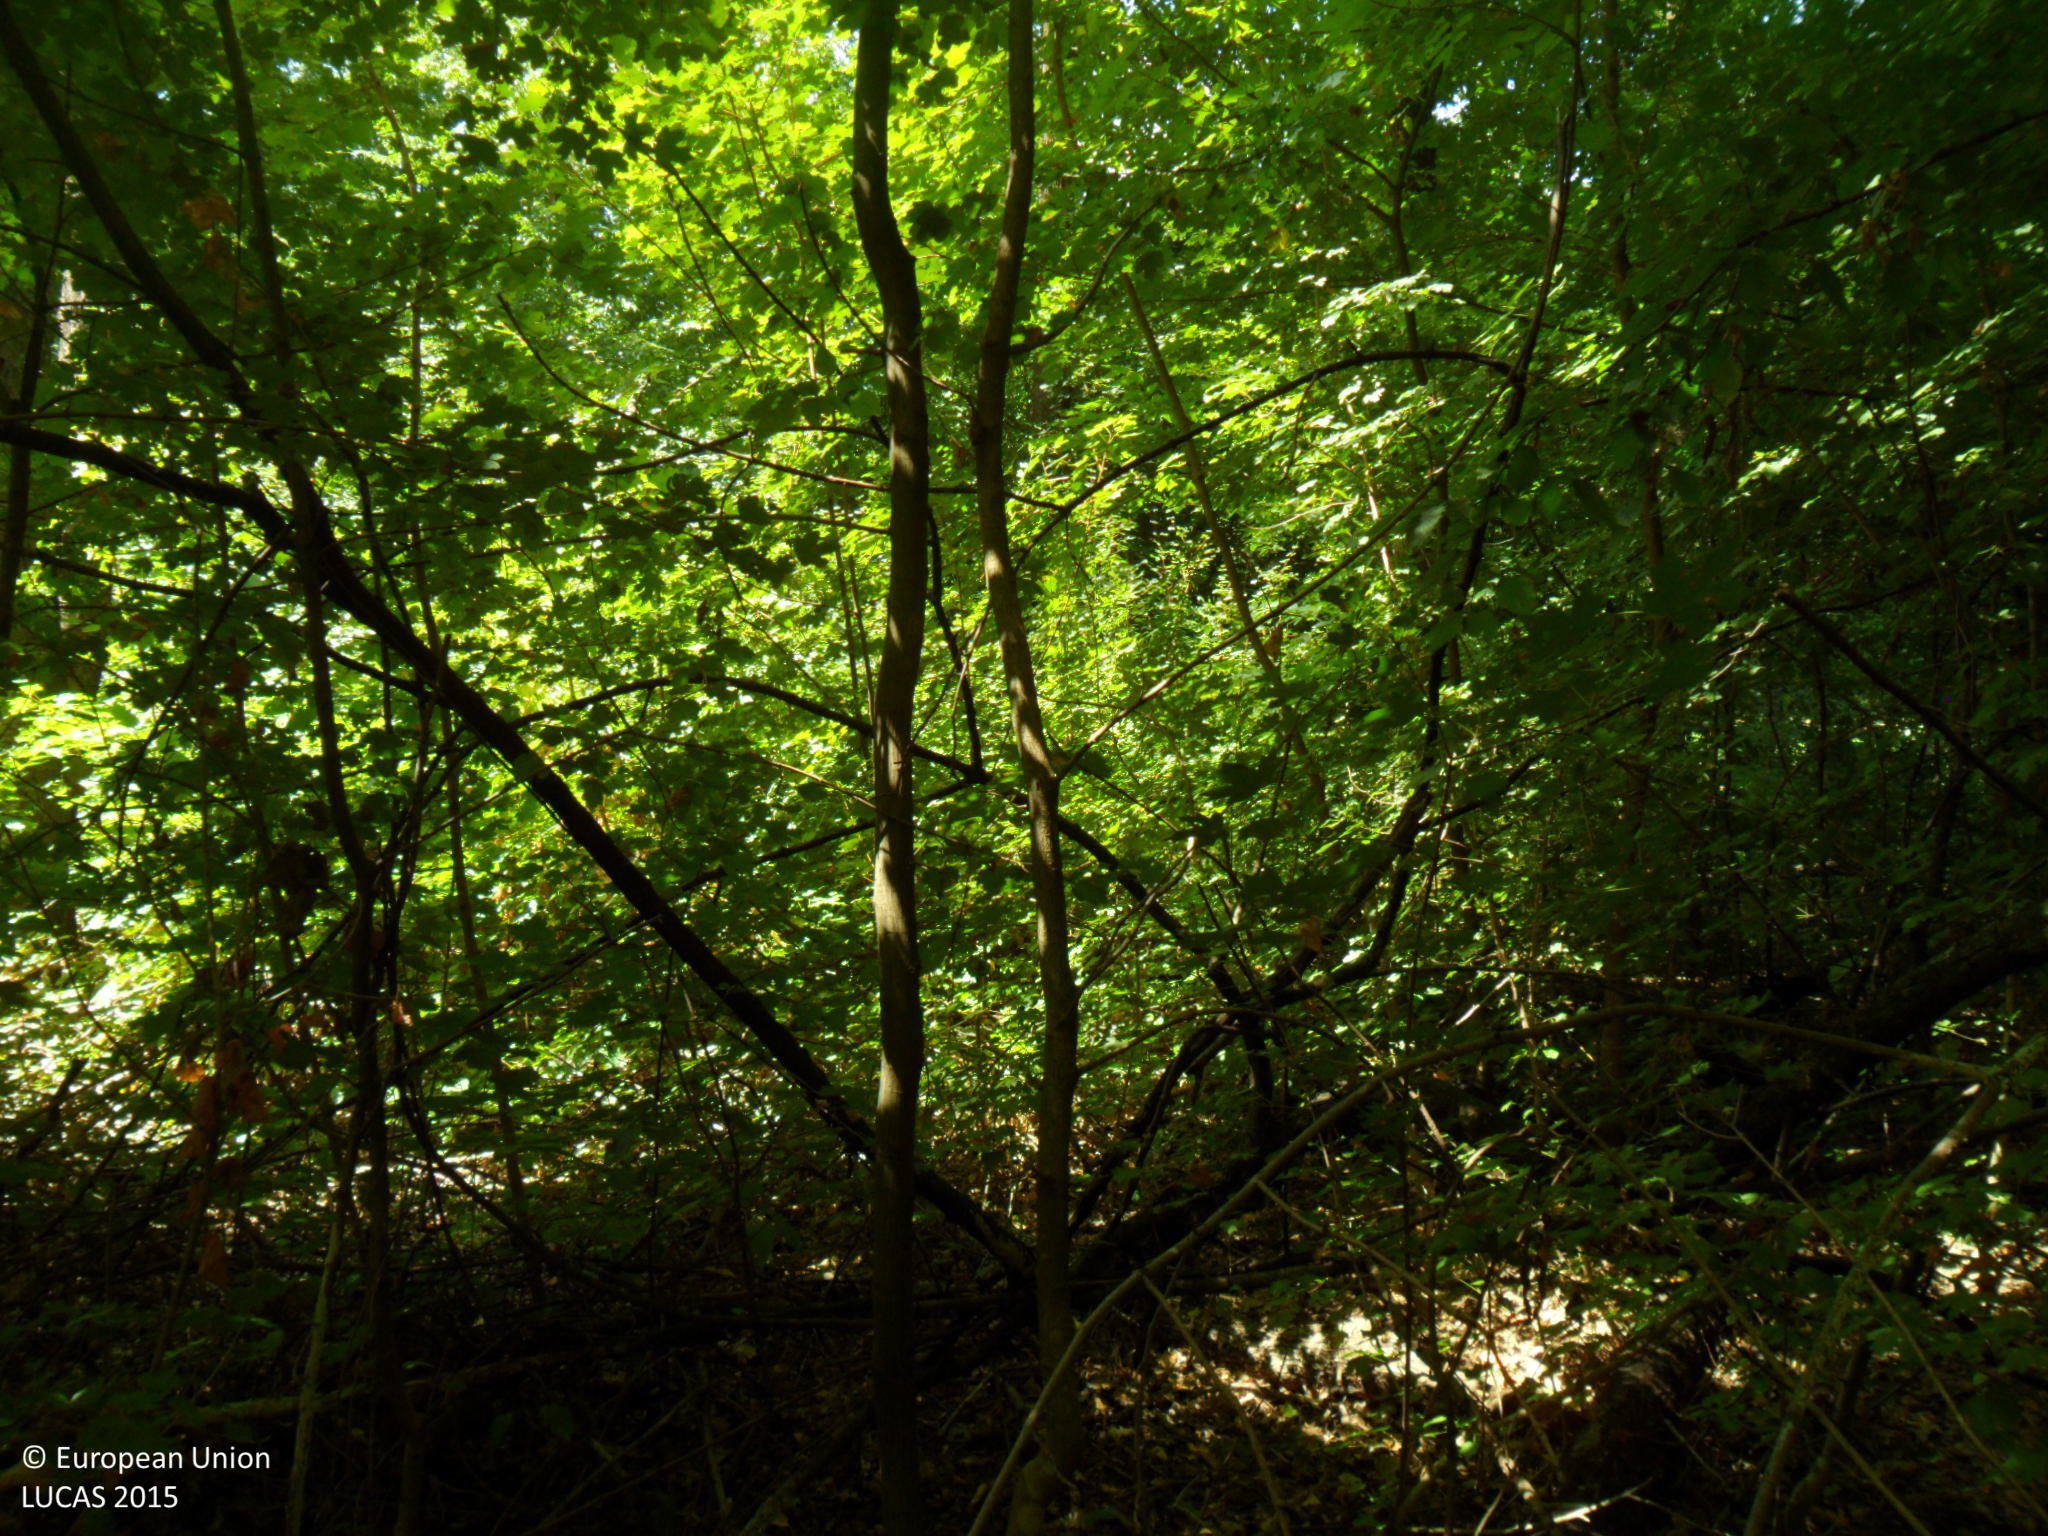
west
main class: Woodland
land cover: Broadleaved woodland
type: mesophytic deciduous forest
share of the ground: > 75 %
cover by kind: broadleaved forest trees 100 %
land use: Forestry
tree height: > 5 m
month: August
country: BG
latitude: 43.5580
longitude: 26.6859
